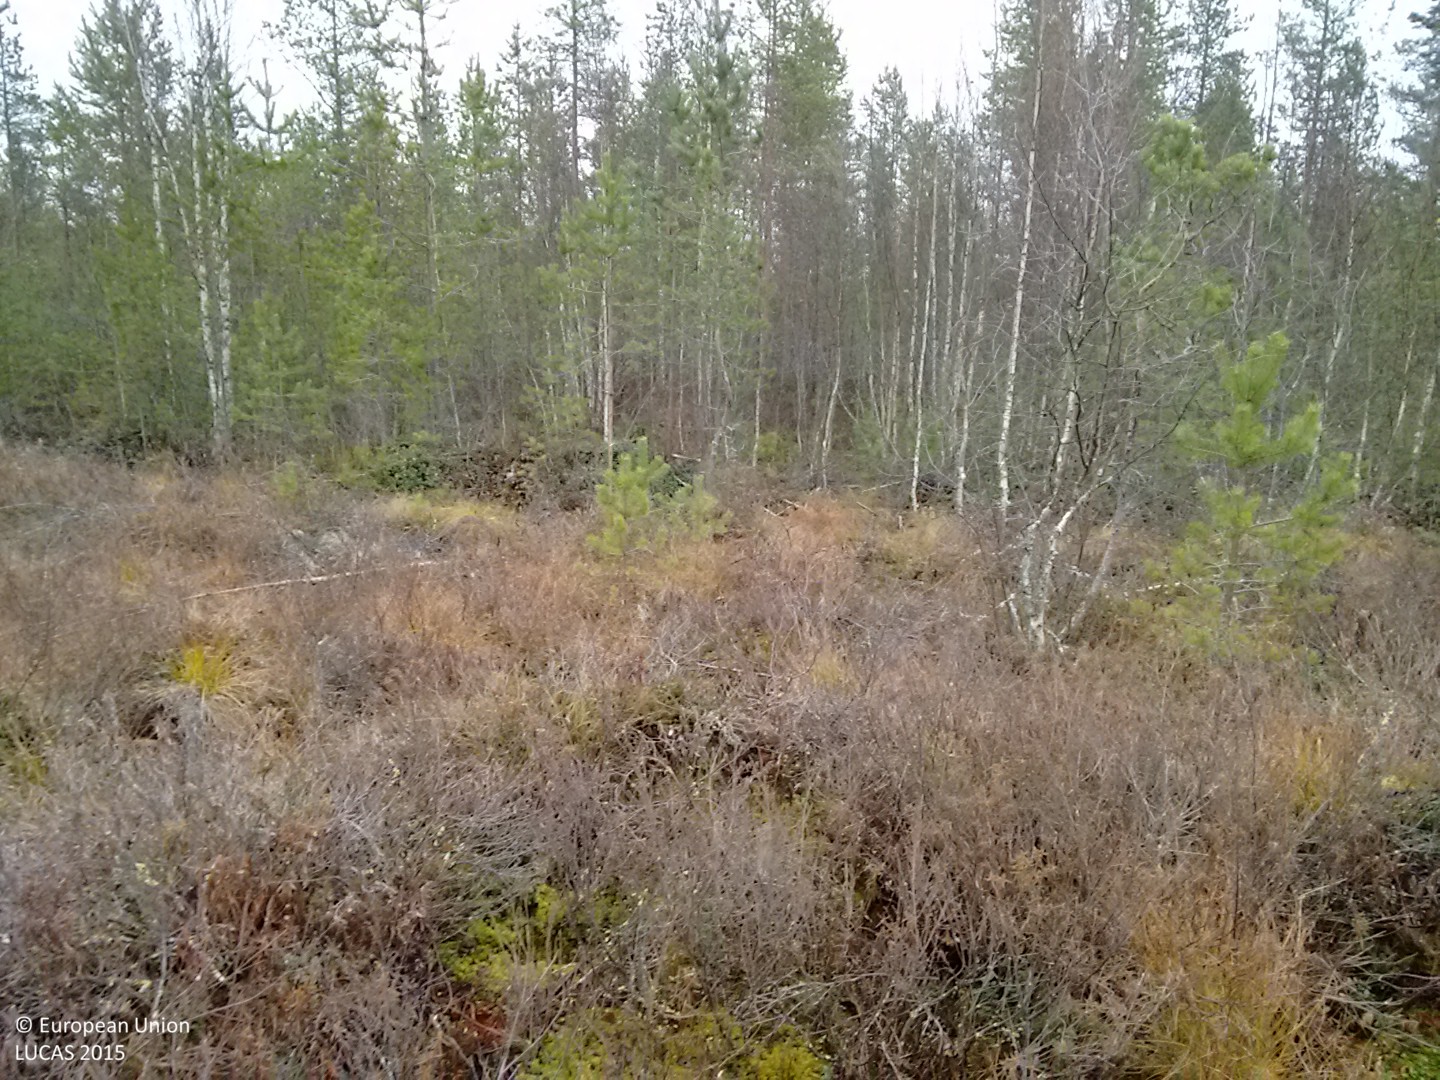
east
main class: Woodland
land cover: Pine dominated mixed woodland
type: boreal forest
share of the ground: 25 - 50 %
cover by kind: shrubs 35 %, broadleaved forest trees 30 %, coniferous forest trees 15 %, herbaceous plants 15 %, lichens and mosses 5 %
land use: Forestry
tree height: < 5 m
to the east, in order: Pine dominated mixed woodland; Ditches and canals; Pine dominated coniferous woodland; Pine dominated mixed woodland; Ditches and canals; Grass margins; Other bare soil; Grass margins; Ditches and canals; Broadleaved woodland
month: October
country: FI
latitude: 64.5656
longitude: 25.3832
